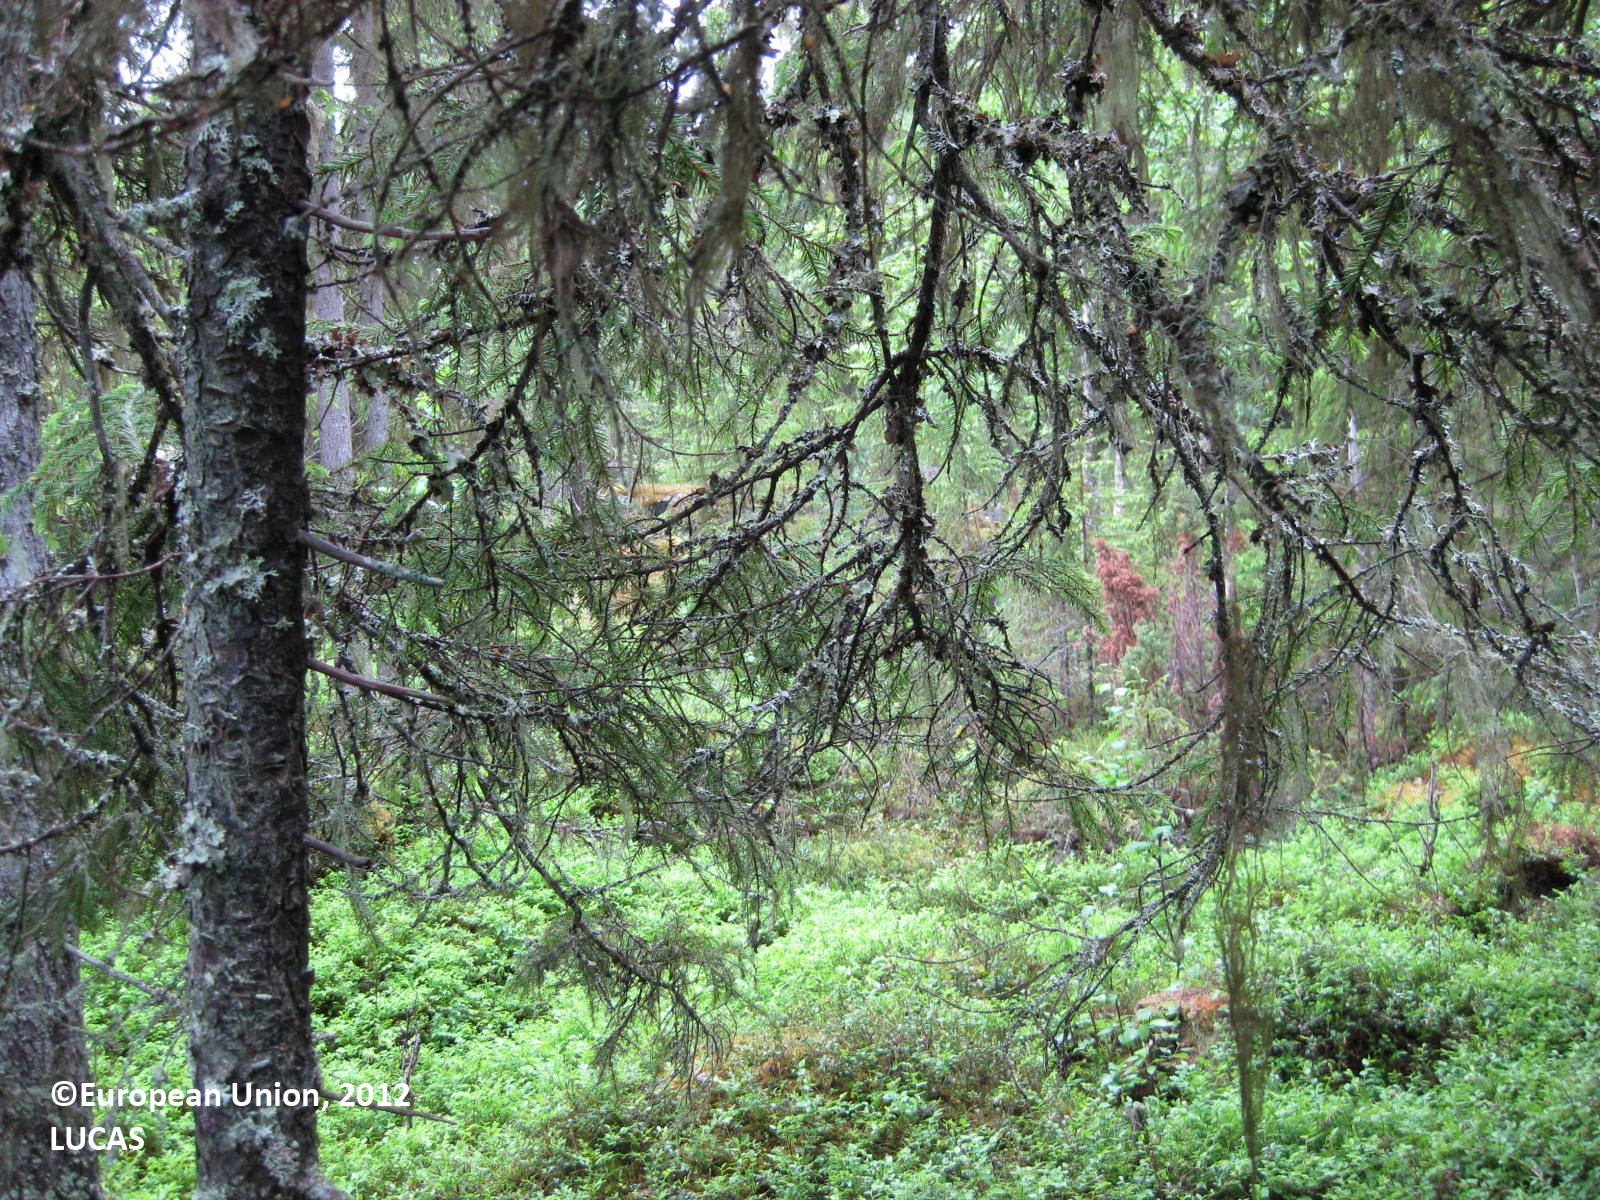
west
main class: Woodland
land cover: Spruce dominated coniferous woodland
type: boreal forest
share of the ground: > 75 %
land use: Forestry
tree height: > 5 m
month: June
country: FI
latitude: 65.1700
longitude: 29.0751
